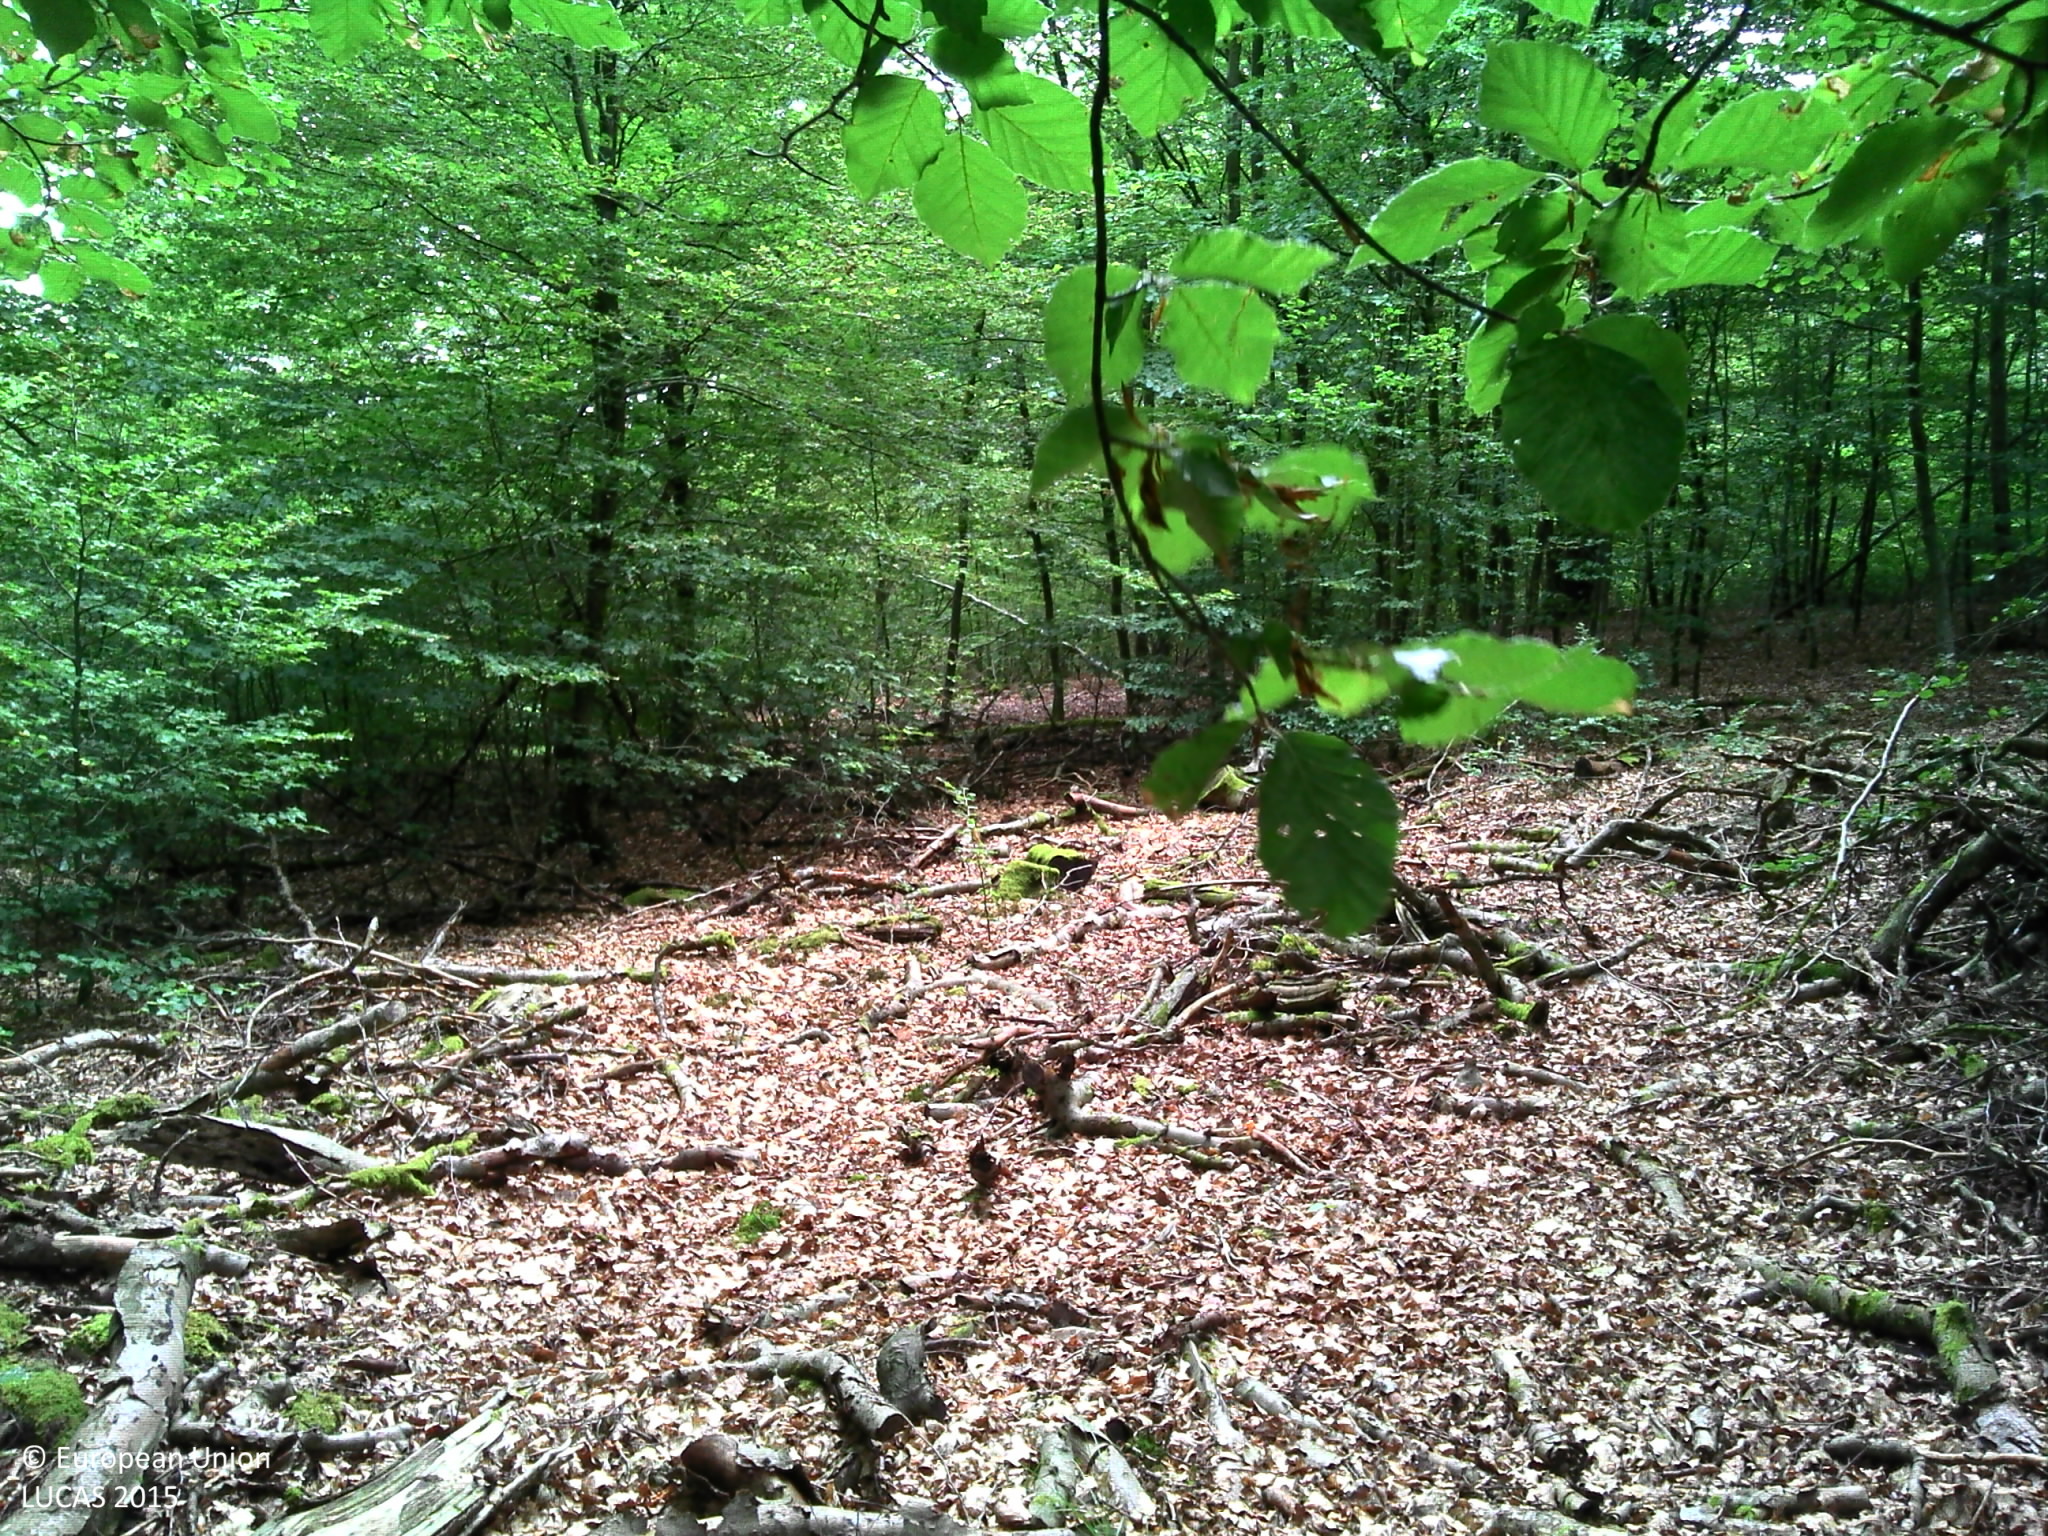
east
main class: Woodland
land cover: Broadleaved woodland
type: beech forest
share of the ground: > 75 %
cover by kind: broadleaved forest trees 90 %, unconsolidated bare surface 10 %
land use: Forestry
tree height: > 5 m
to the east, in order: Broadleaved woodland; Tracks; Broadleaved woodland
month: July
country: BE
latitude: 49.7783
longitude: 5.6798
